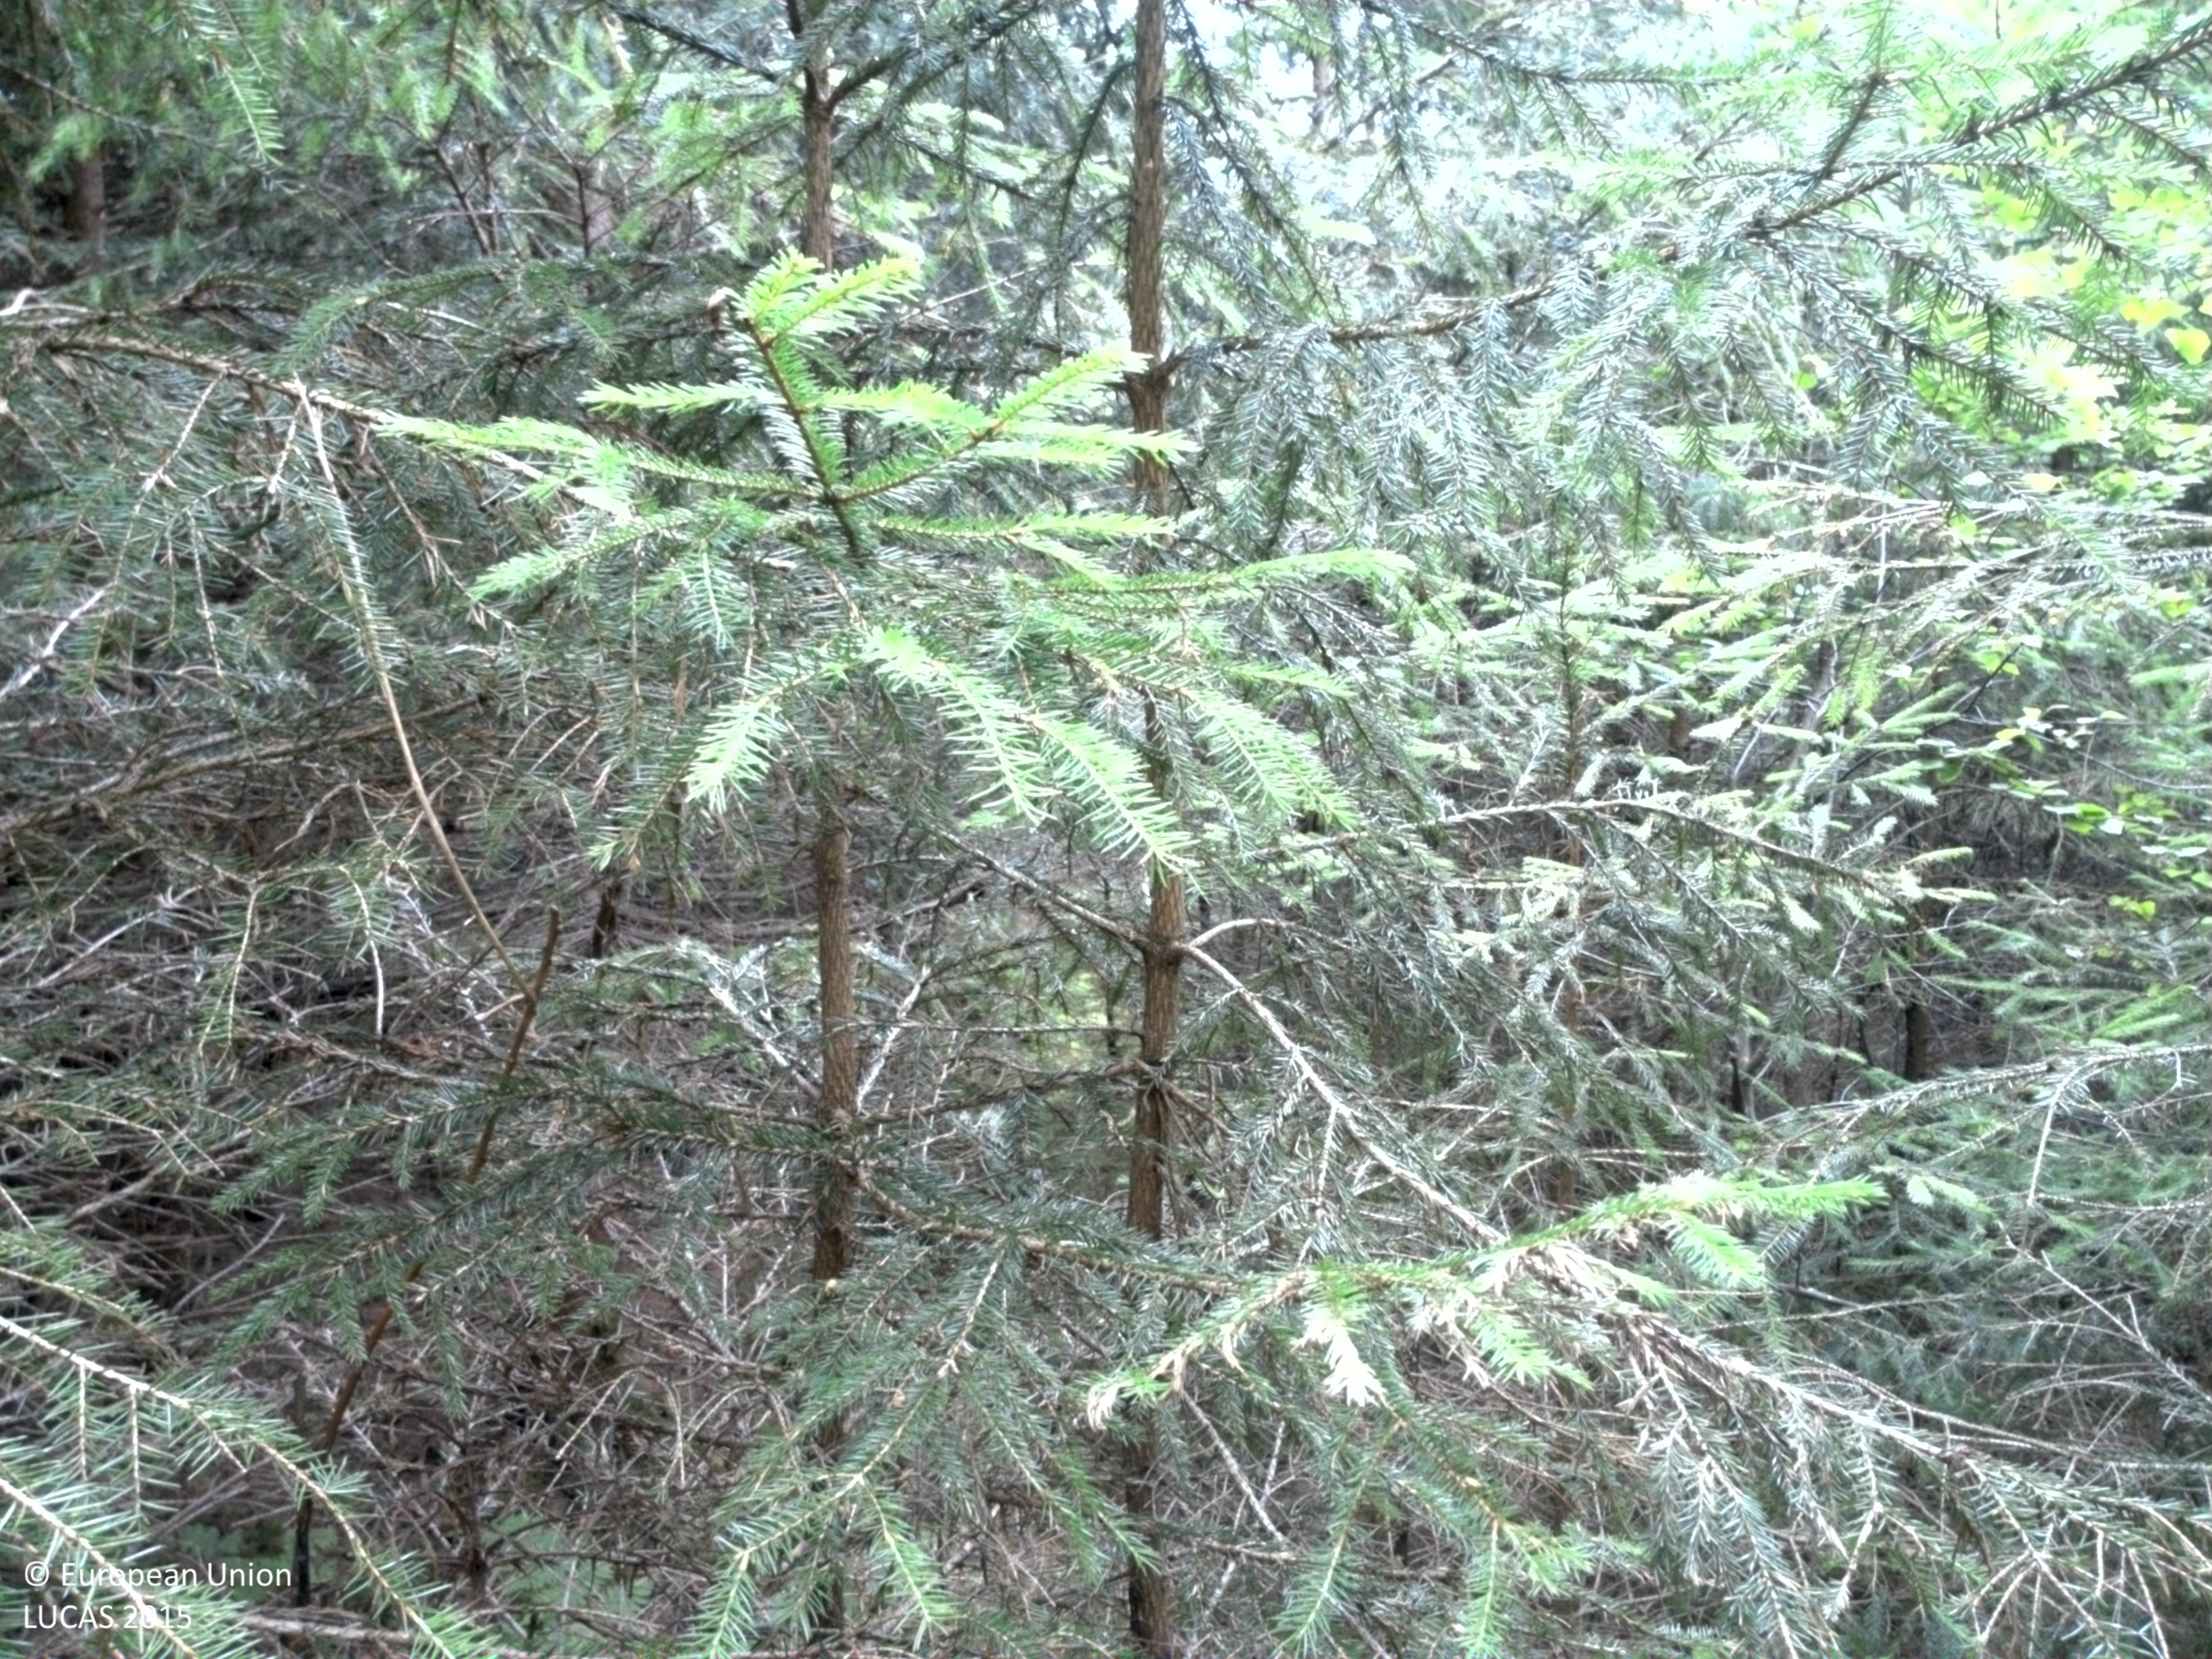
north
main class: Woodland
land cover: Spruce dominated mixed woodland
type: boreal forest
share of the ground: 50 - 75 %
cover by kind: coniferous forest trees 55 %, broadleaved forest trees 20 %, herbaceous plants 15 %, lichens and mosses 10 %
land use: Forestry
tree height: < 5 m
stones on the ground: < 10 %
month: July
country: SE
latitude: 60.0573
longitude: 13.0629
